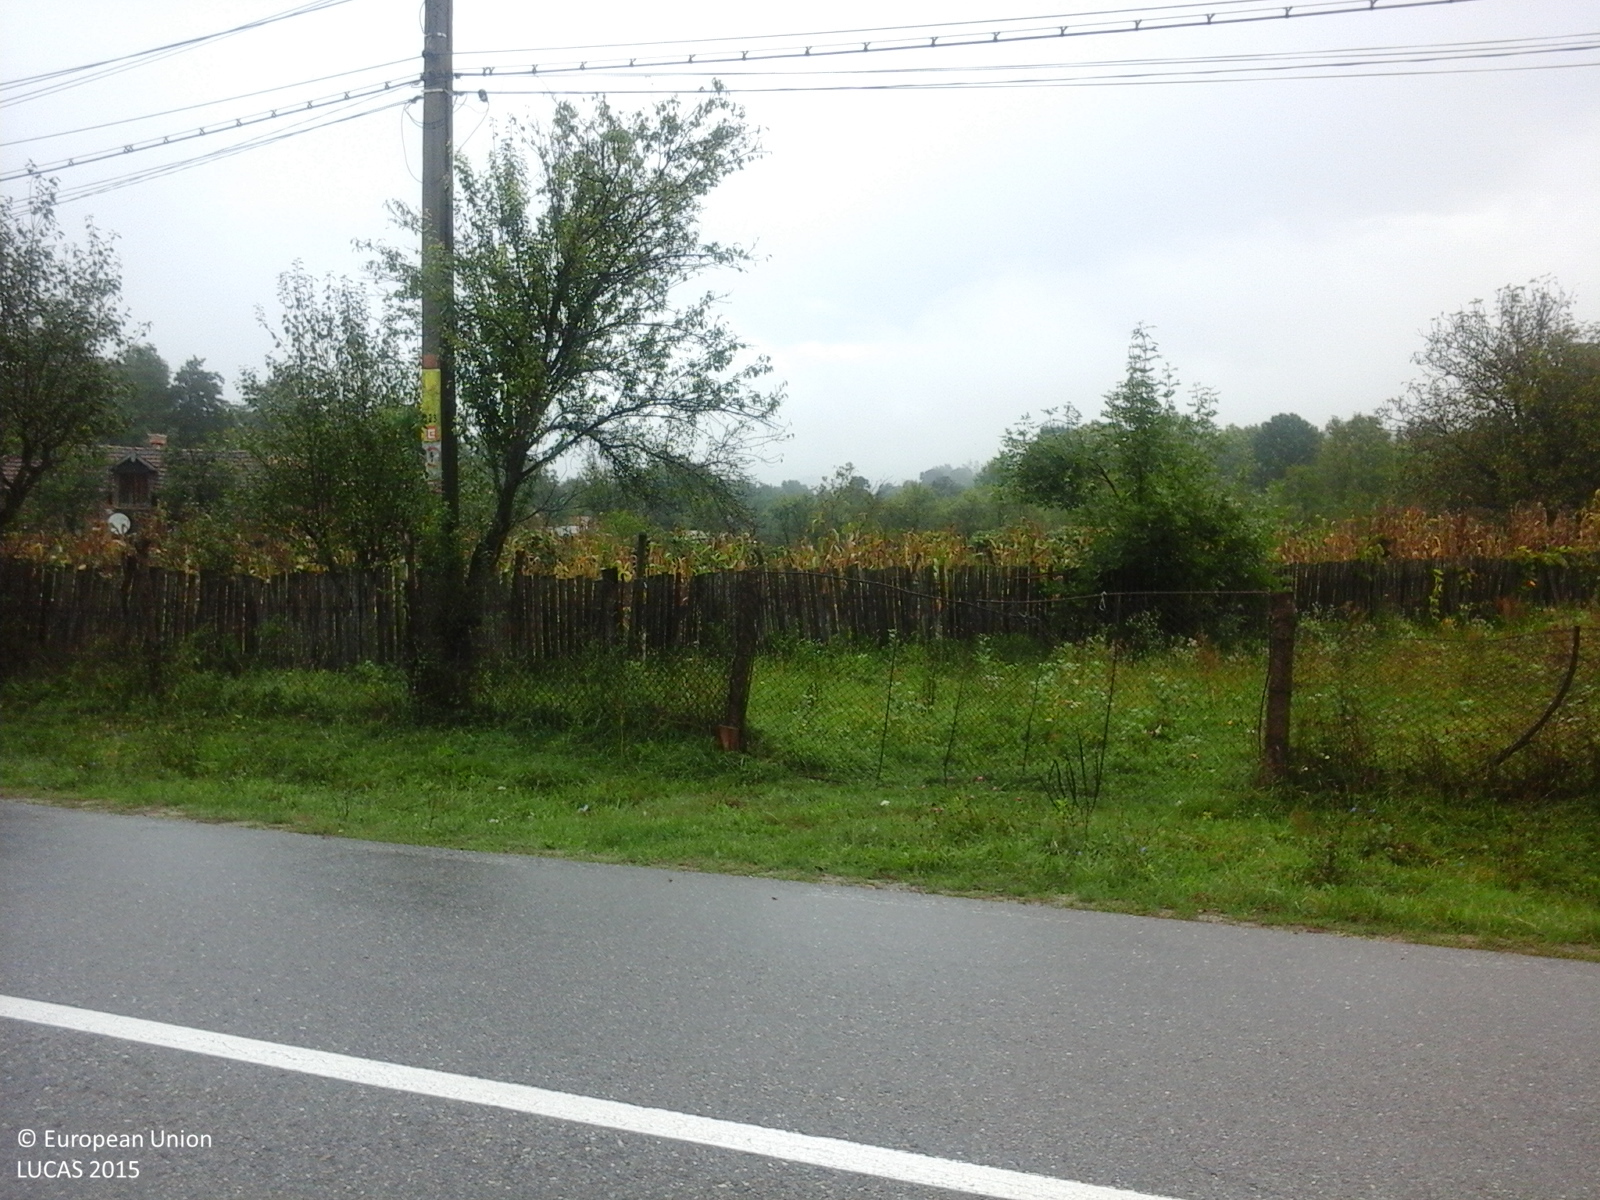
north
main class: Cropland
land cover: Vineyards
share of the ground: 10 - 25 %
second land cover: Grassland without tree/shrub cover
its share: > 75 %
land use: Kitchen garden
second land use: Residential
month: September
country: RO
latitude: 45.1660
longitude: 23.6101
